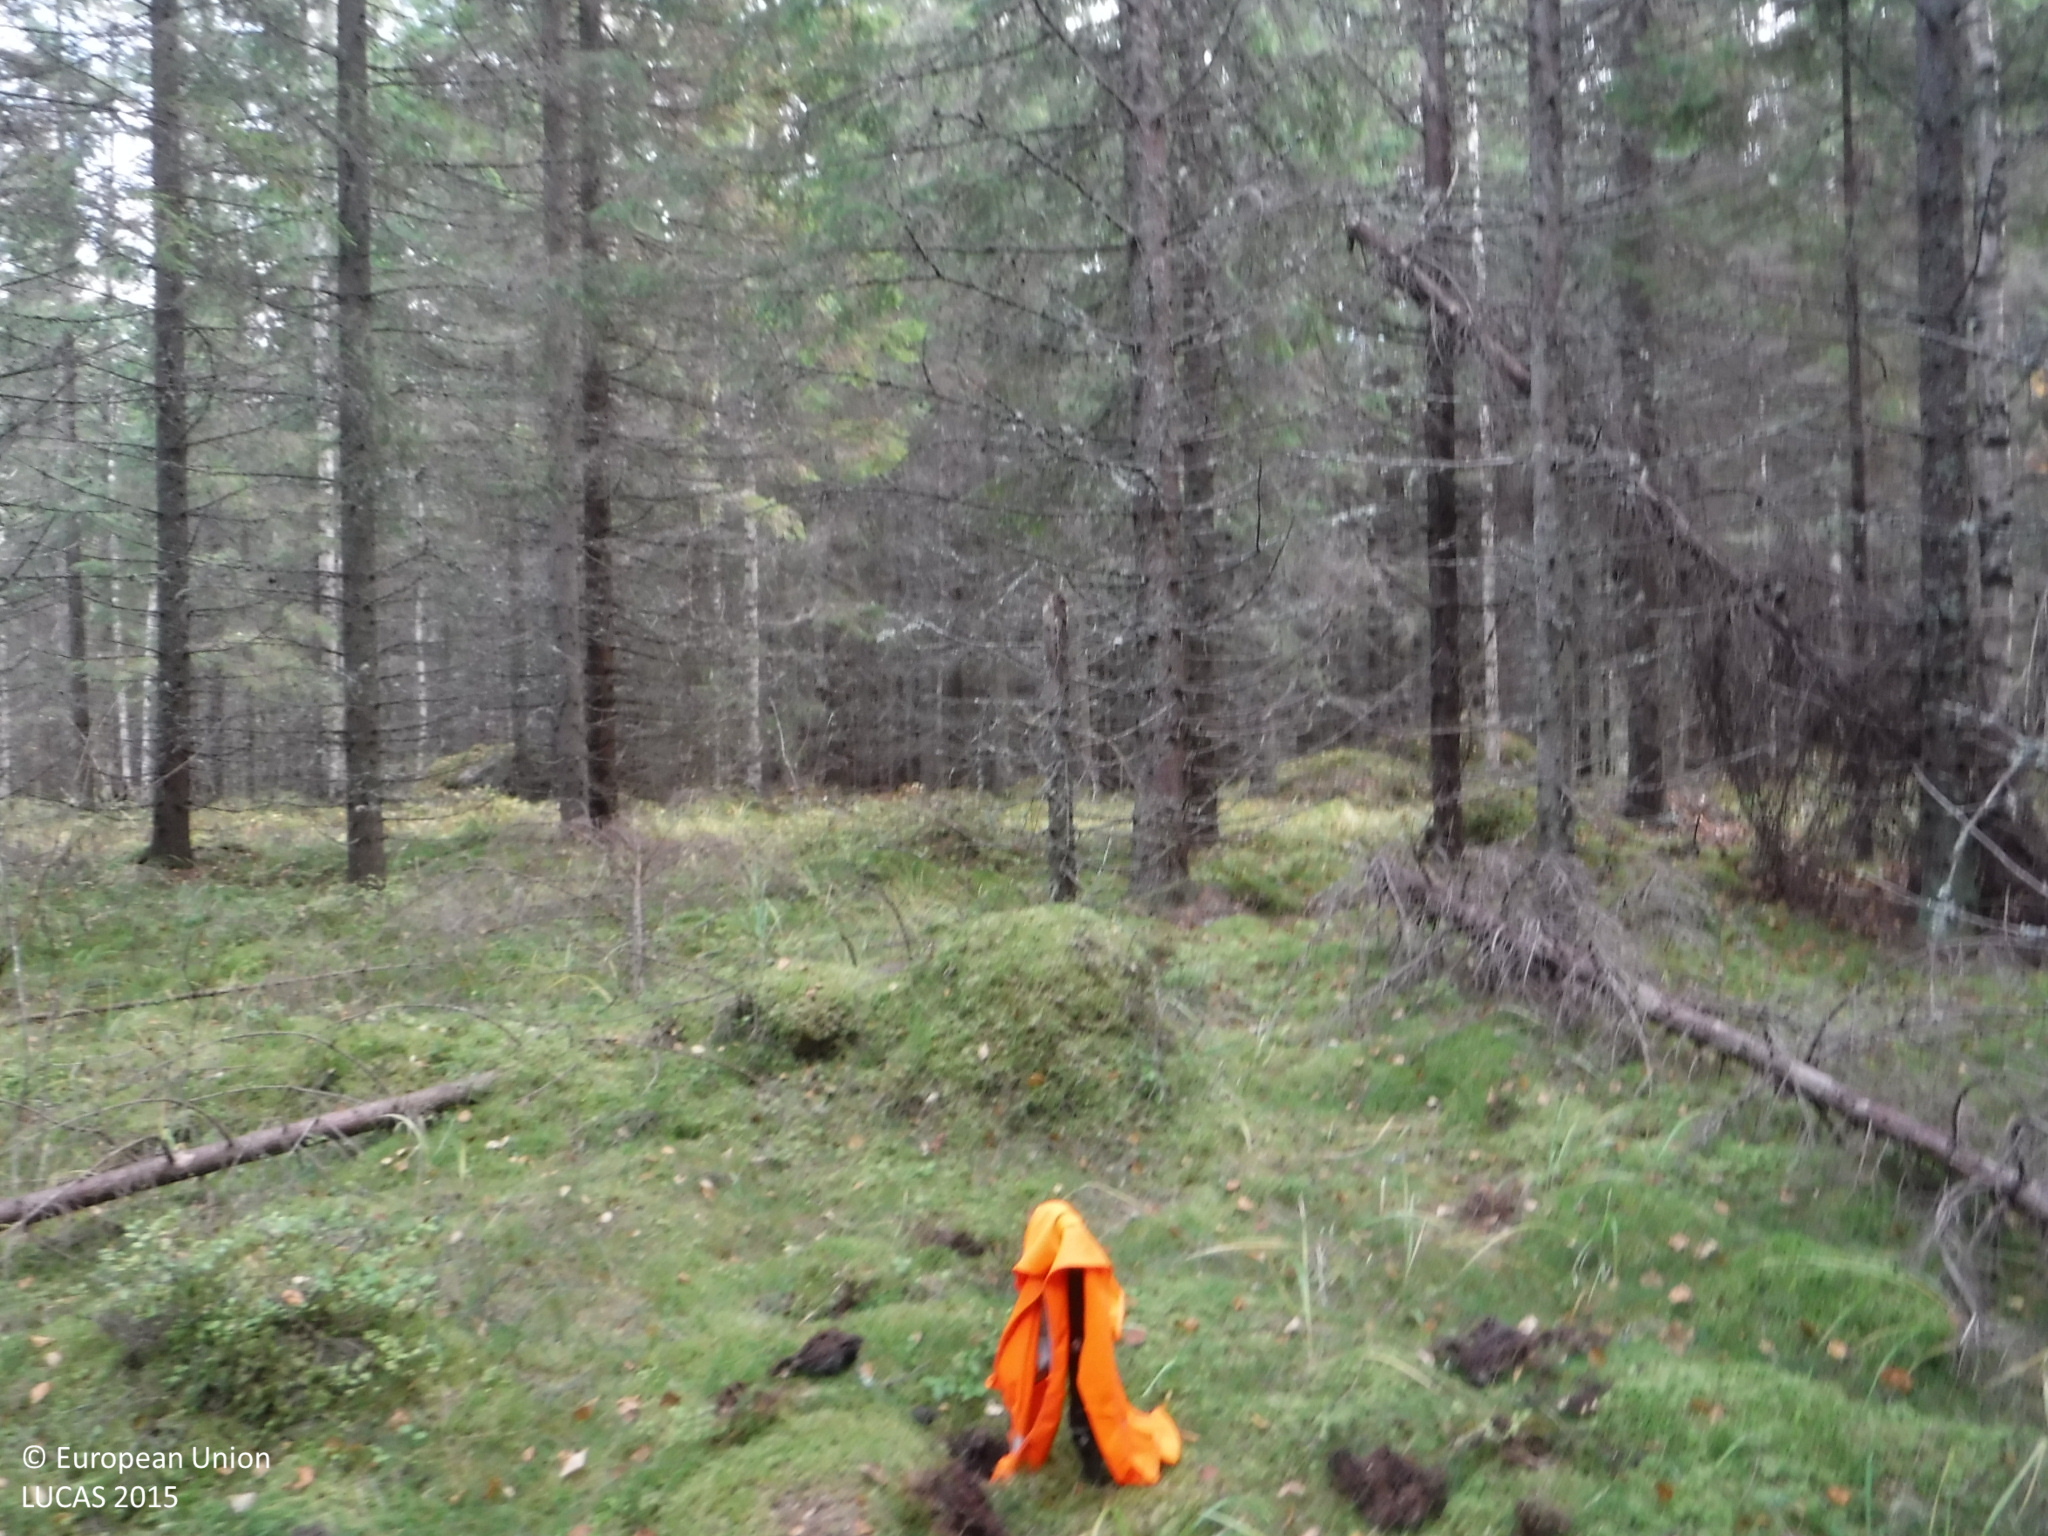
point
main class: Woodland
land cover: Spruce dominated coniferous woodland
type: boreal forest
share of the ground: > 75 %
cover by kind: coniferous forest trees 75 %, lichens and mosses 20 %, shrubs 5 %
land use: Forestry
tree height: > 5 m
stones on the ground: 25 - 50 %
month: October
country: FI
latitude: 61.9758
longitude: 25.9441
